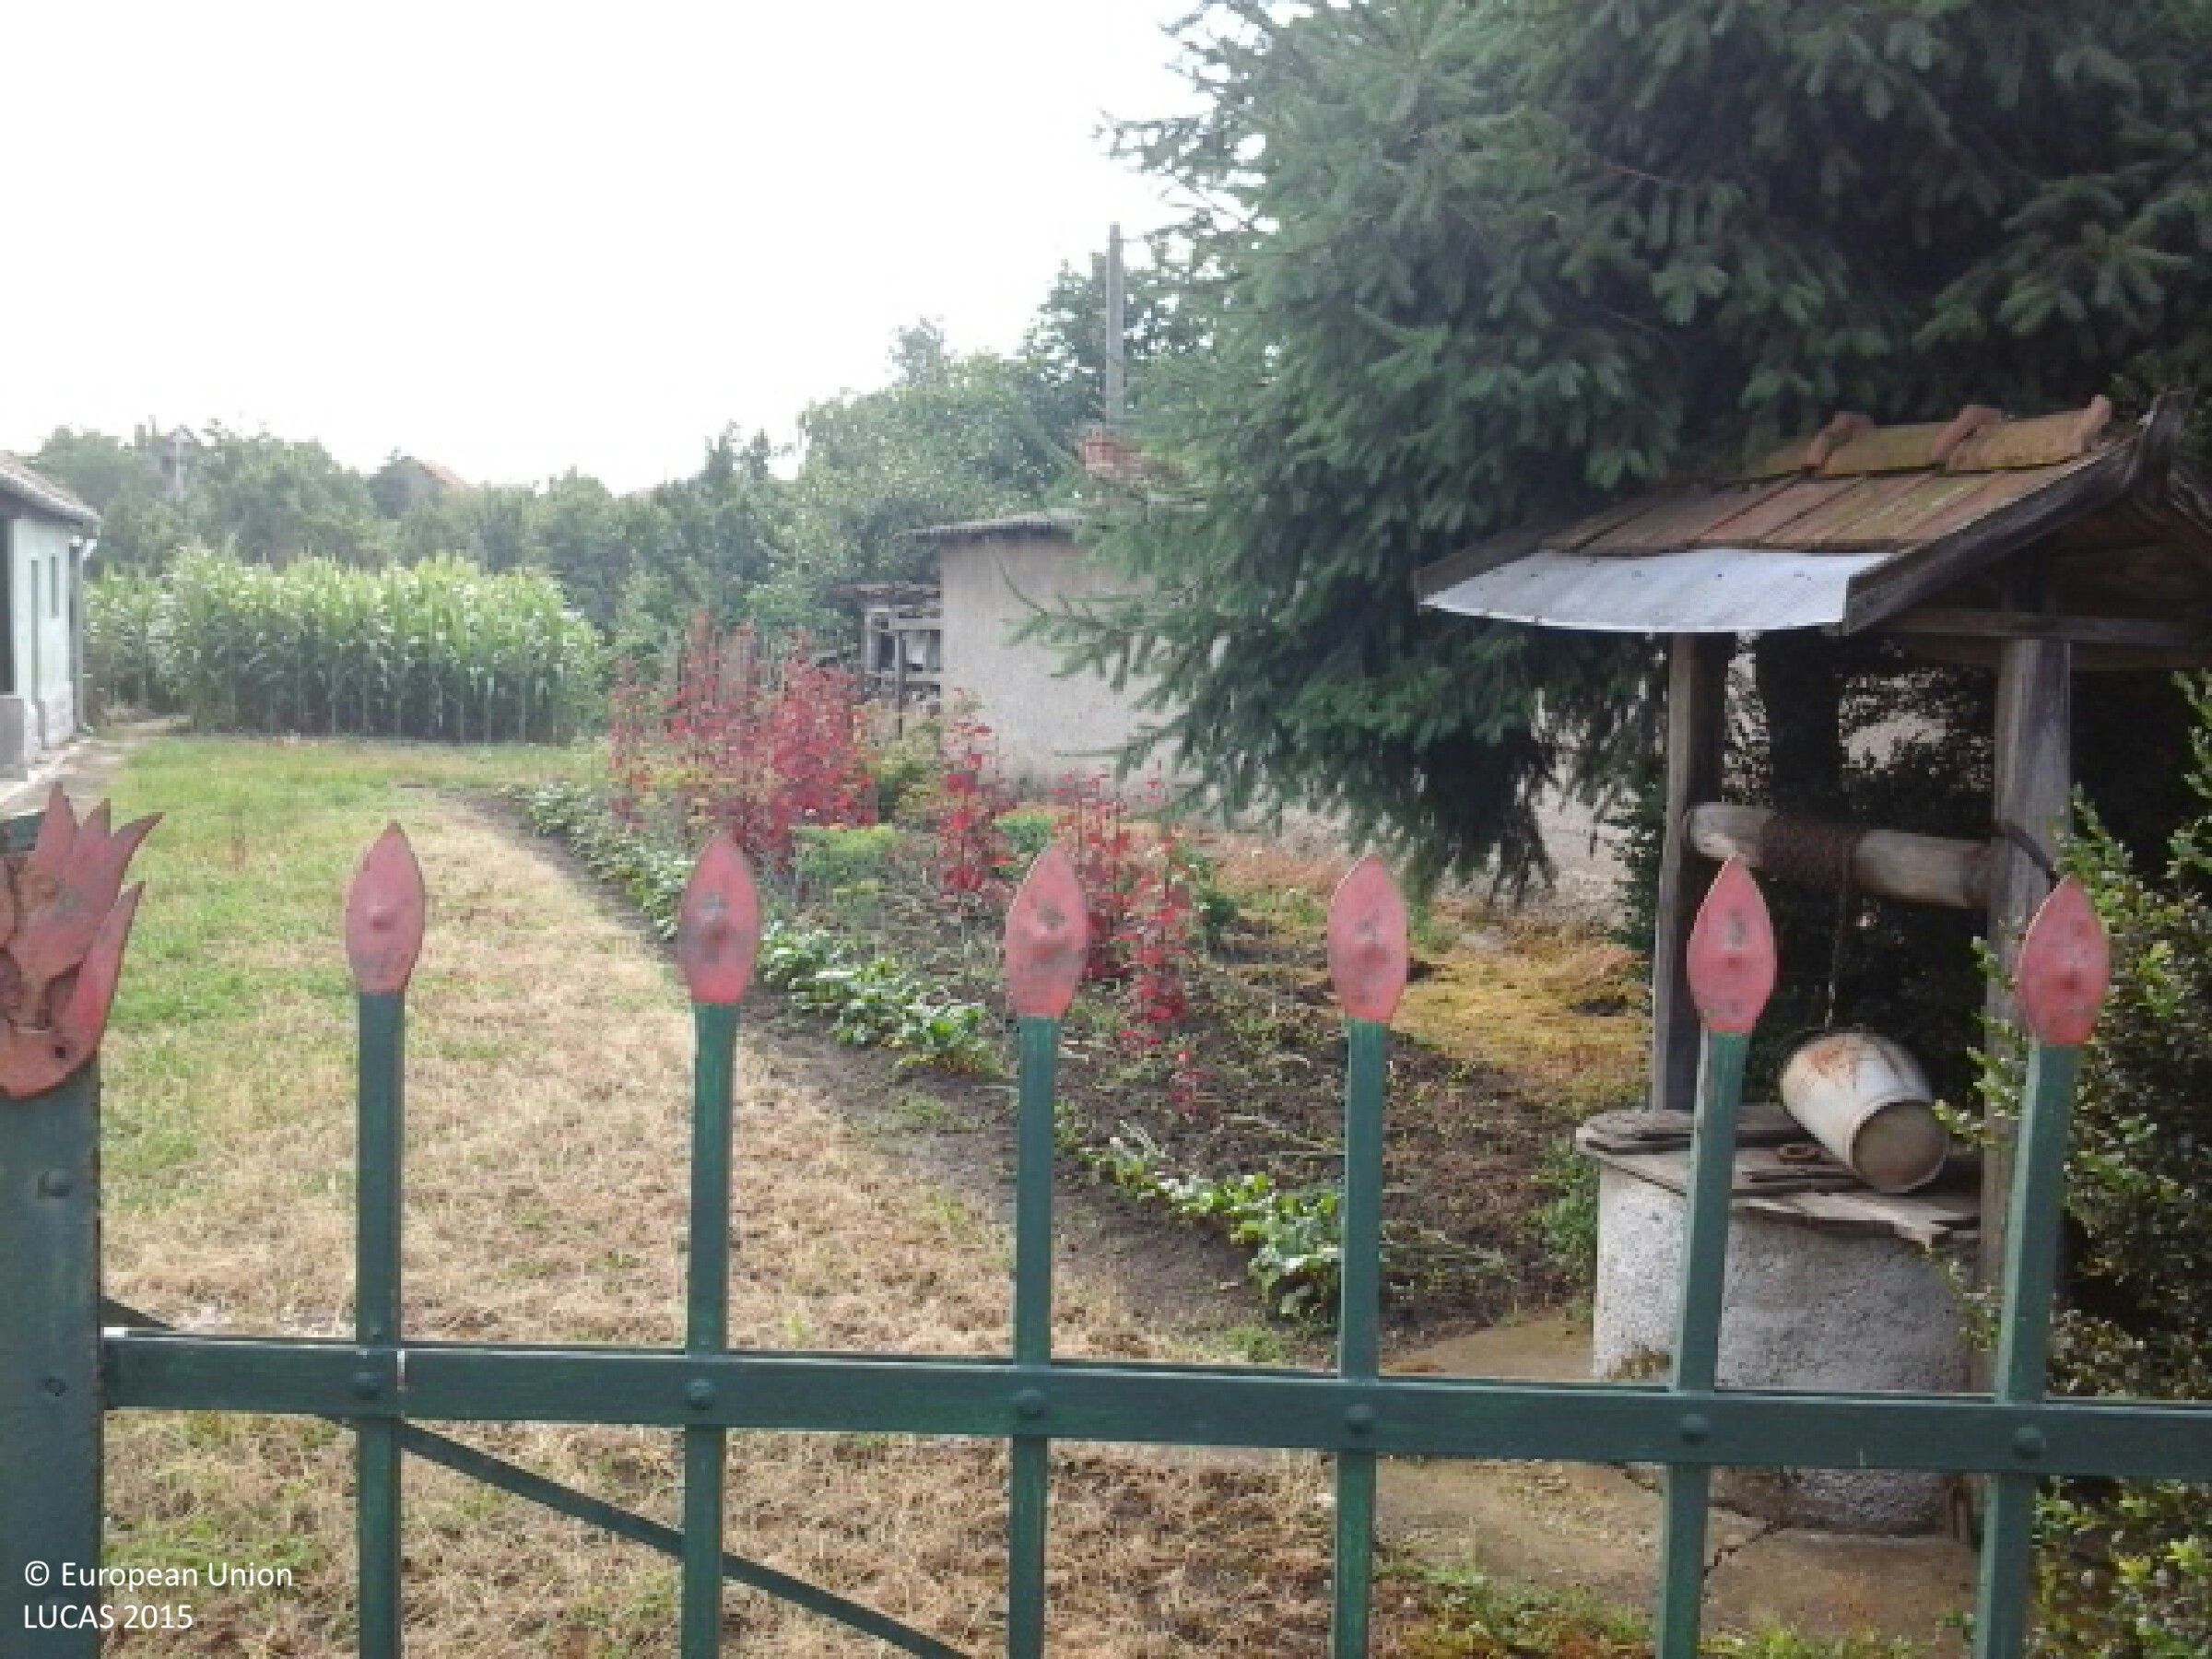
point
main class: Grassland
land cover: Grassland without tree/shrub cover
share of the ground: > 75 %
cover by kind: herbaceous plants 100 %
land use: Residential
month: July
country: HU
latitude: 48.2054
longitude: 20.9246
